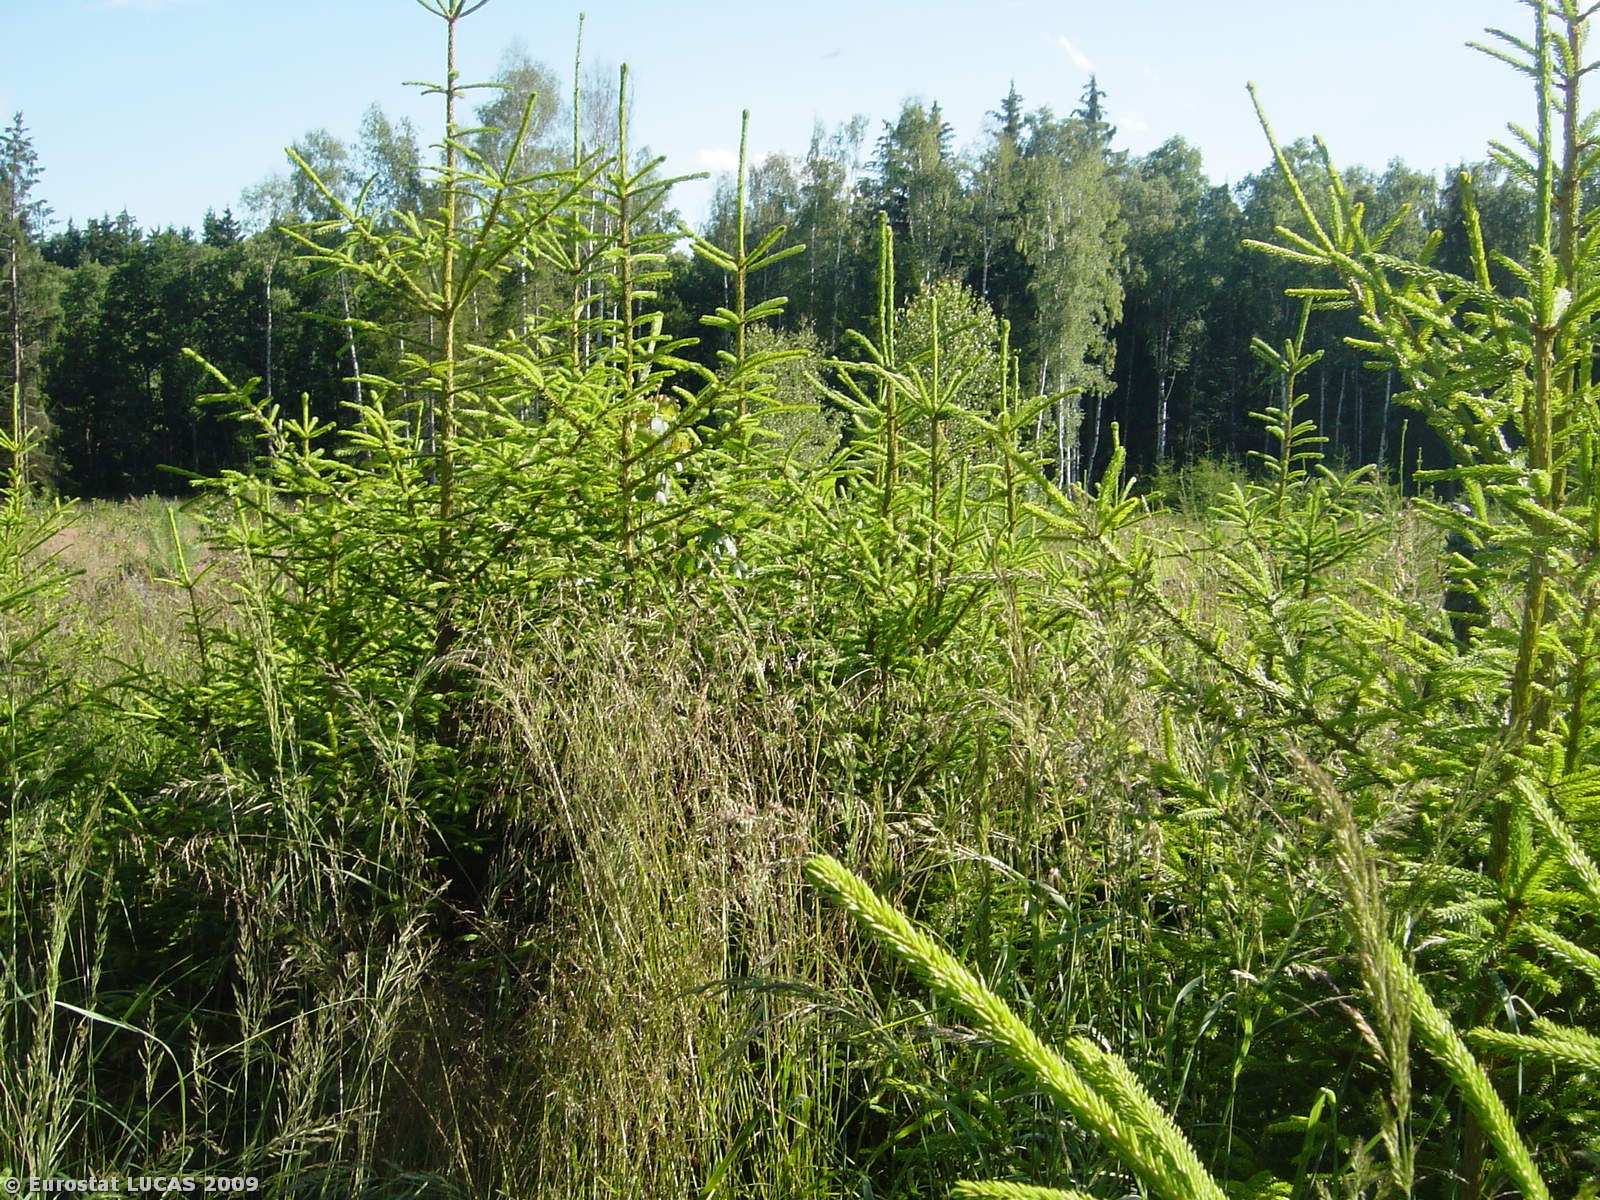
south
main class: Woodland
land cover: Coniferous woodland
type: hemiboreal forest and nemoral coniferous forest and mixed broadleaved-coniferous forest
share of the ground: > 75 %
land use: Forestry
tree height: > 5 m
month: July
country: CZ
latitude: 49.8413
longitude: 12.9060
